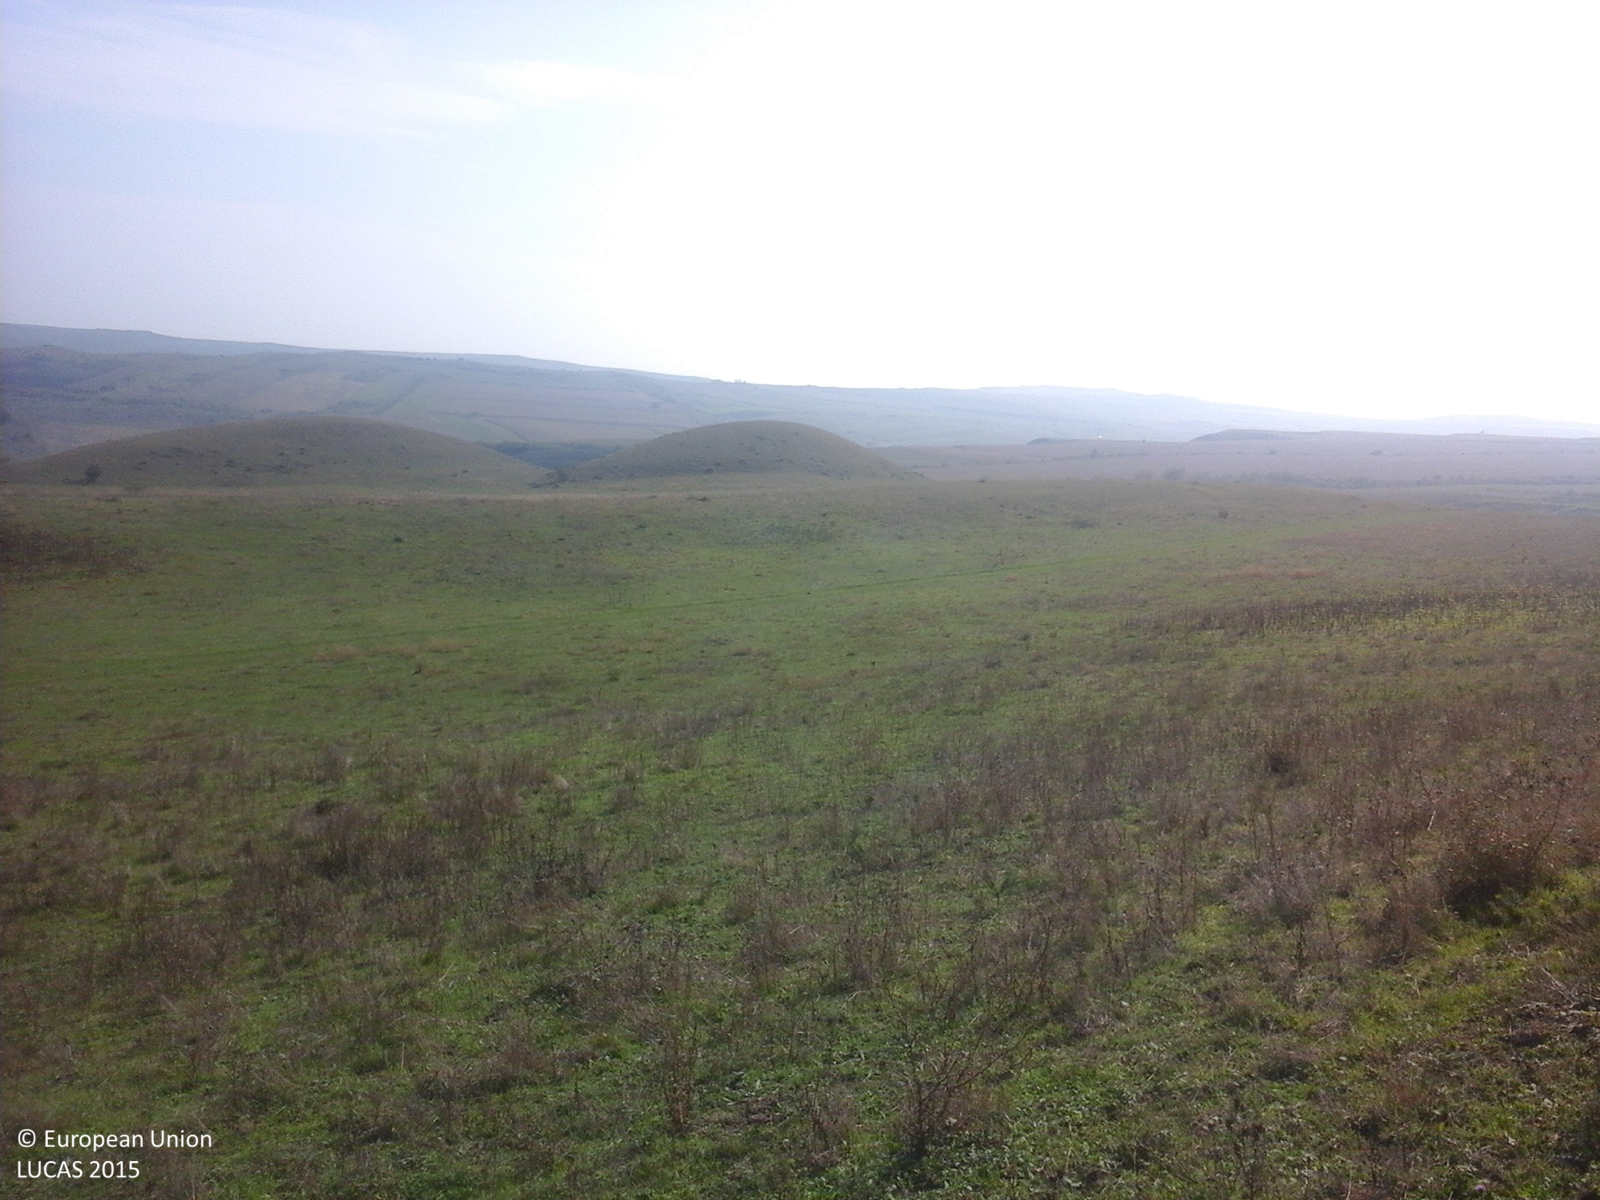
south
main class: Grassland
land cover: Spontaneously vegetated surfaces
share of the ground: > 75 %
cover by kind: herbaceous plants 100 %
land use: Fallow land
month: October
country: RO
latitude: 46.3288
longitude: 23.9344
